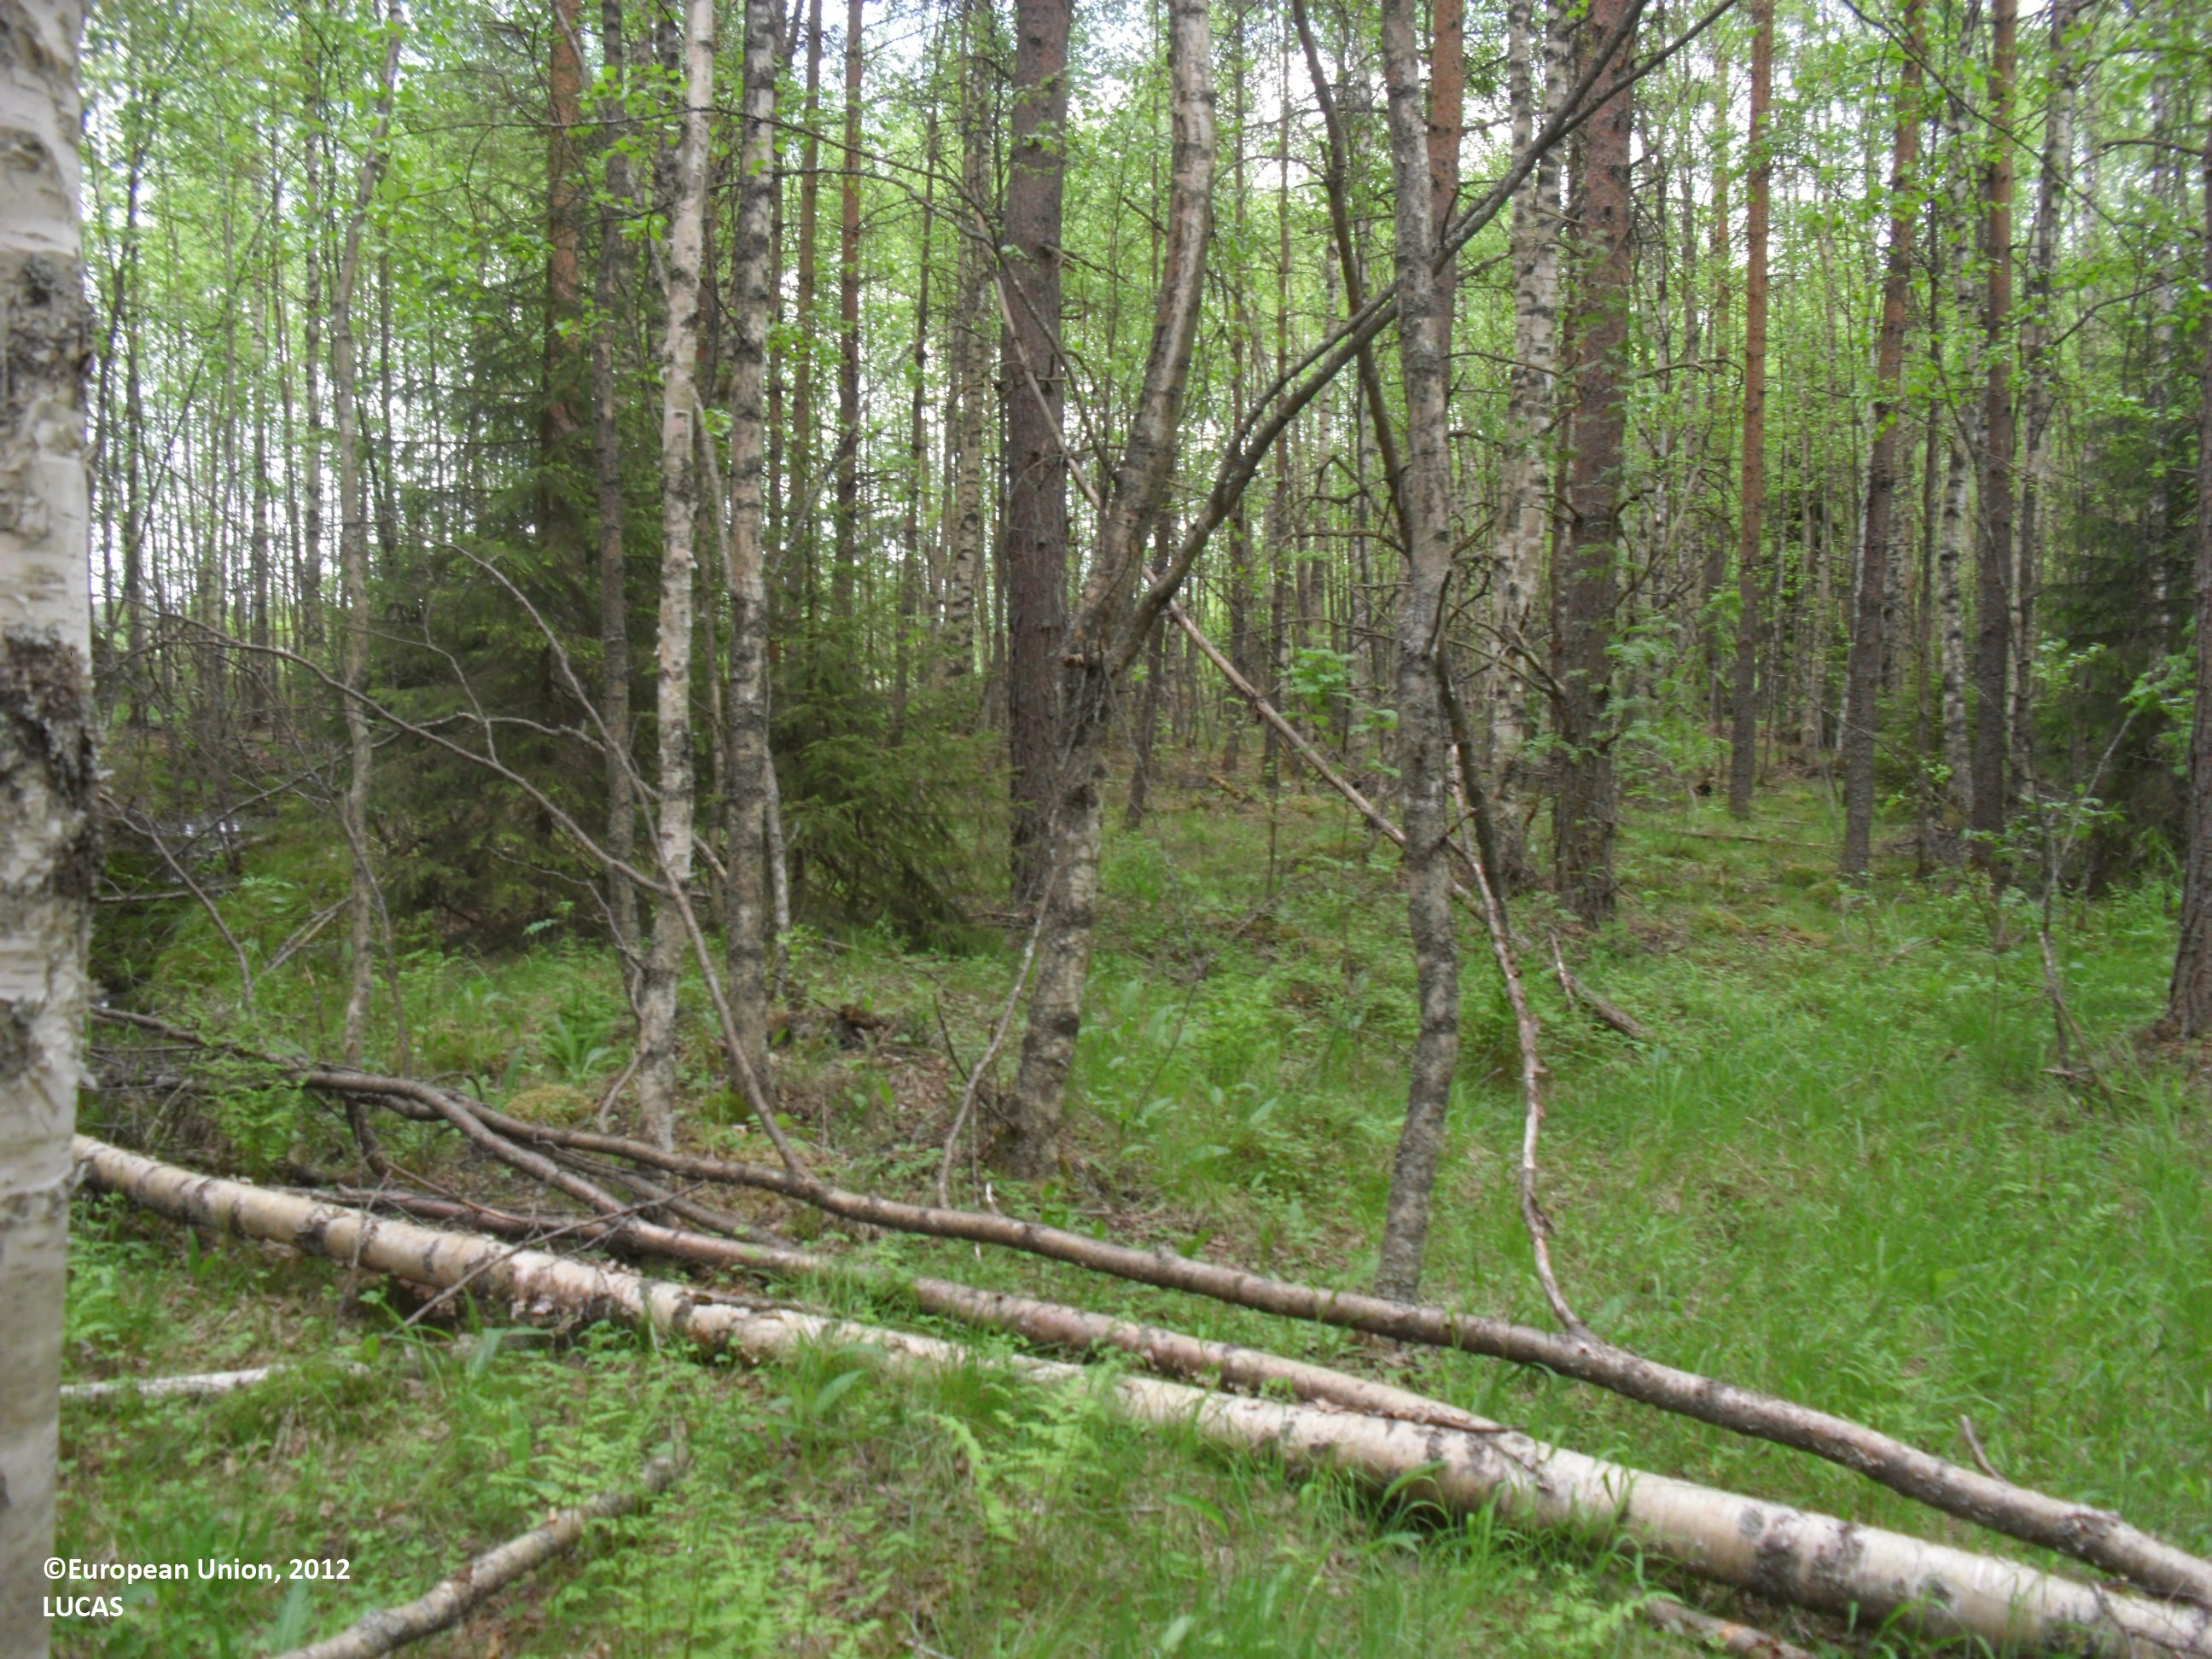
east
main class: Woodland
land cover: Other mixed woodland
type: boreal forest
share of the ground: 50 - 75 %
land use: Forestry
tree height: > 5 m
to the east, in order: Other mixed woodland; Ditches and canals; Broadleaved woodland; Artificial constructions; Other mixed woodland; Oats; Lines of trees; Ditches and canals; Grassland without tree/shrub cover
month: June
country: FI
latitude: 62.9112
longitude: 22.9517
